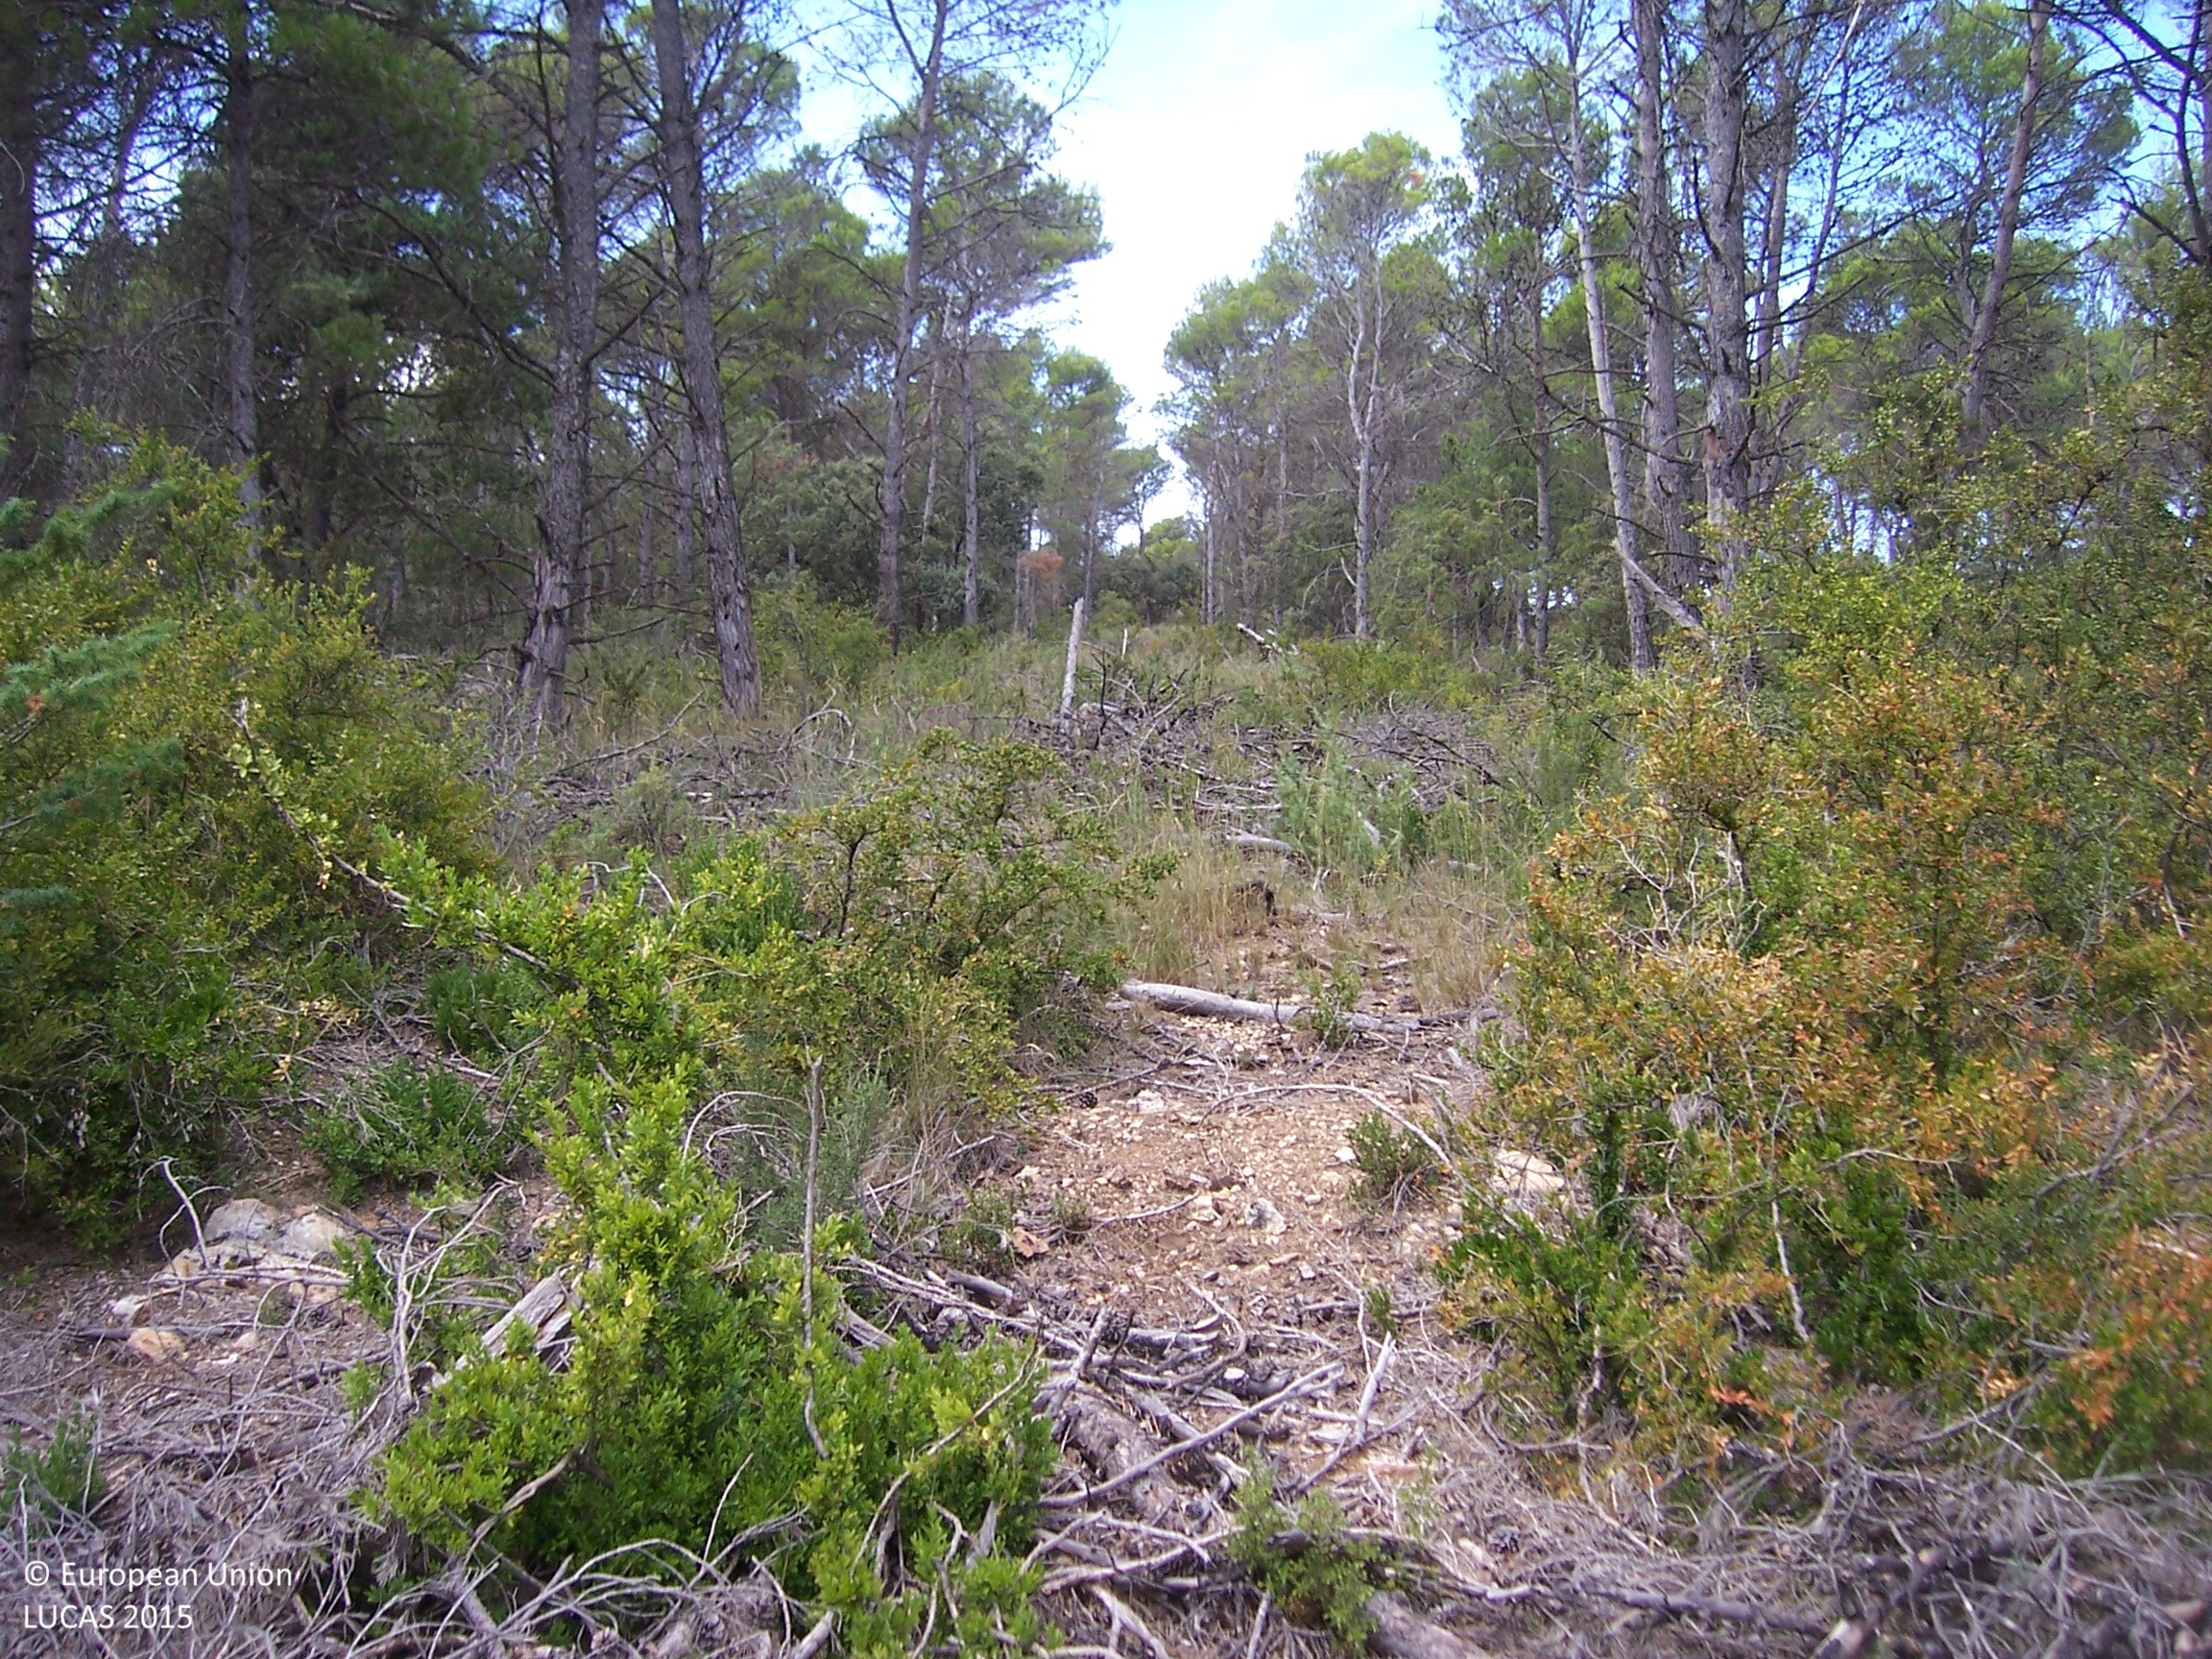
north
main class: Woodland
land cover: Pine dominated coniferous woodland
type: coniferous forest of the mediterranean region
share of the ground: 25 - 50 %
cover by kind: coniferous forest trees 40 %, shrubs 30 %, herbaceous plants 20 %, consolidated bare surface 10 %
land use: Forestry
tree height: > 5 m
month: August
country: ES
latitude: 41.9691
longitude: 0.4876
